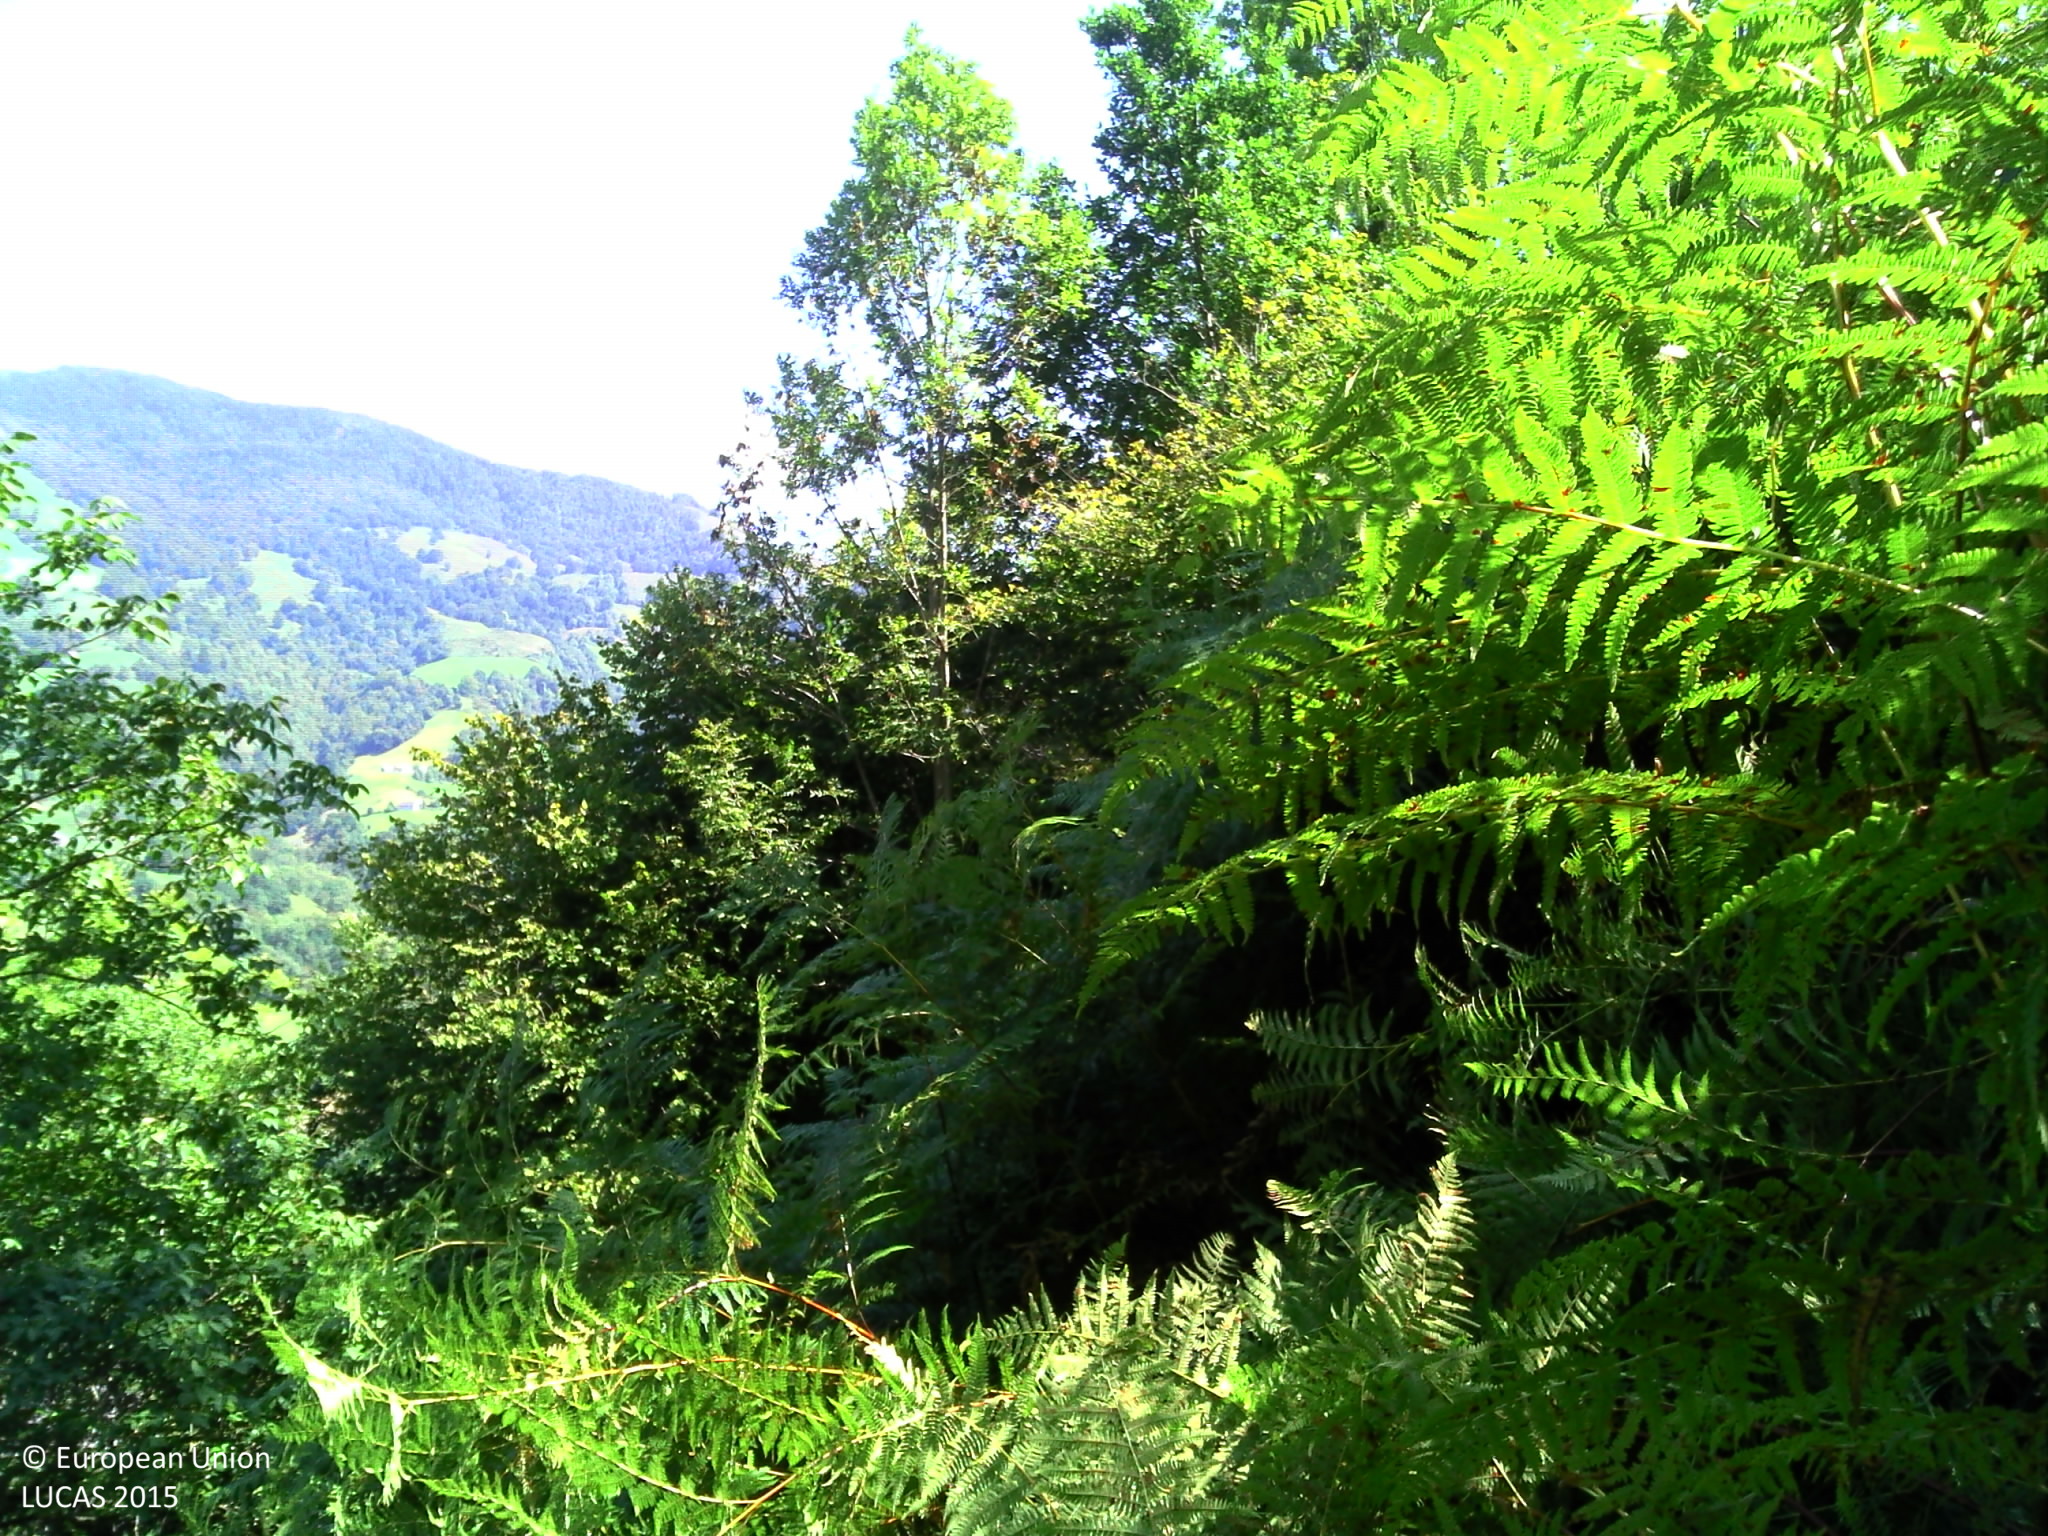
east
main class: Woodland
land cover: Broadleaved woodland
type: acidophilous oak and oak-birch forest
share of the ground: 50 - 75 %
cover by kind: broadleaved forest trees 60 %, herbaceous plants 30 %, shrubs 5 %, consolidated bare surface 5 %
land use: Forestry
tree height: > 5 m
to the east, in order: Broadleaved woodland; Fences; Broadleaved woodland; Tracks; Broadleaved woodland; Fences; Shrubland with sparse tree cover; Grassland without tree/shrub cover; Electric lines; Grassland without tree/shrub cover; Shruby margins; Dry stone walls; Fences; Grassland without tree/shrub cover
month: September
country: FR
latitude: 43.0141
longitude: -0.8673
